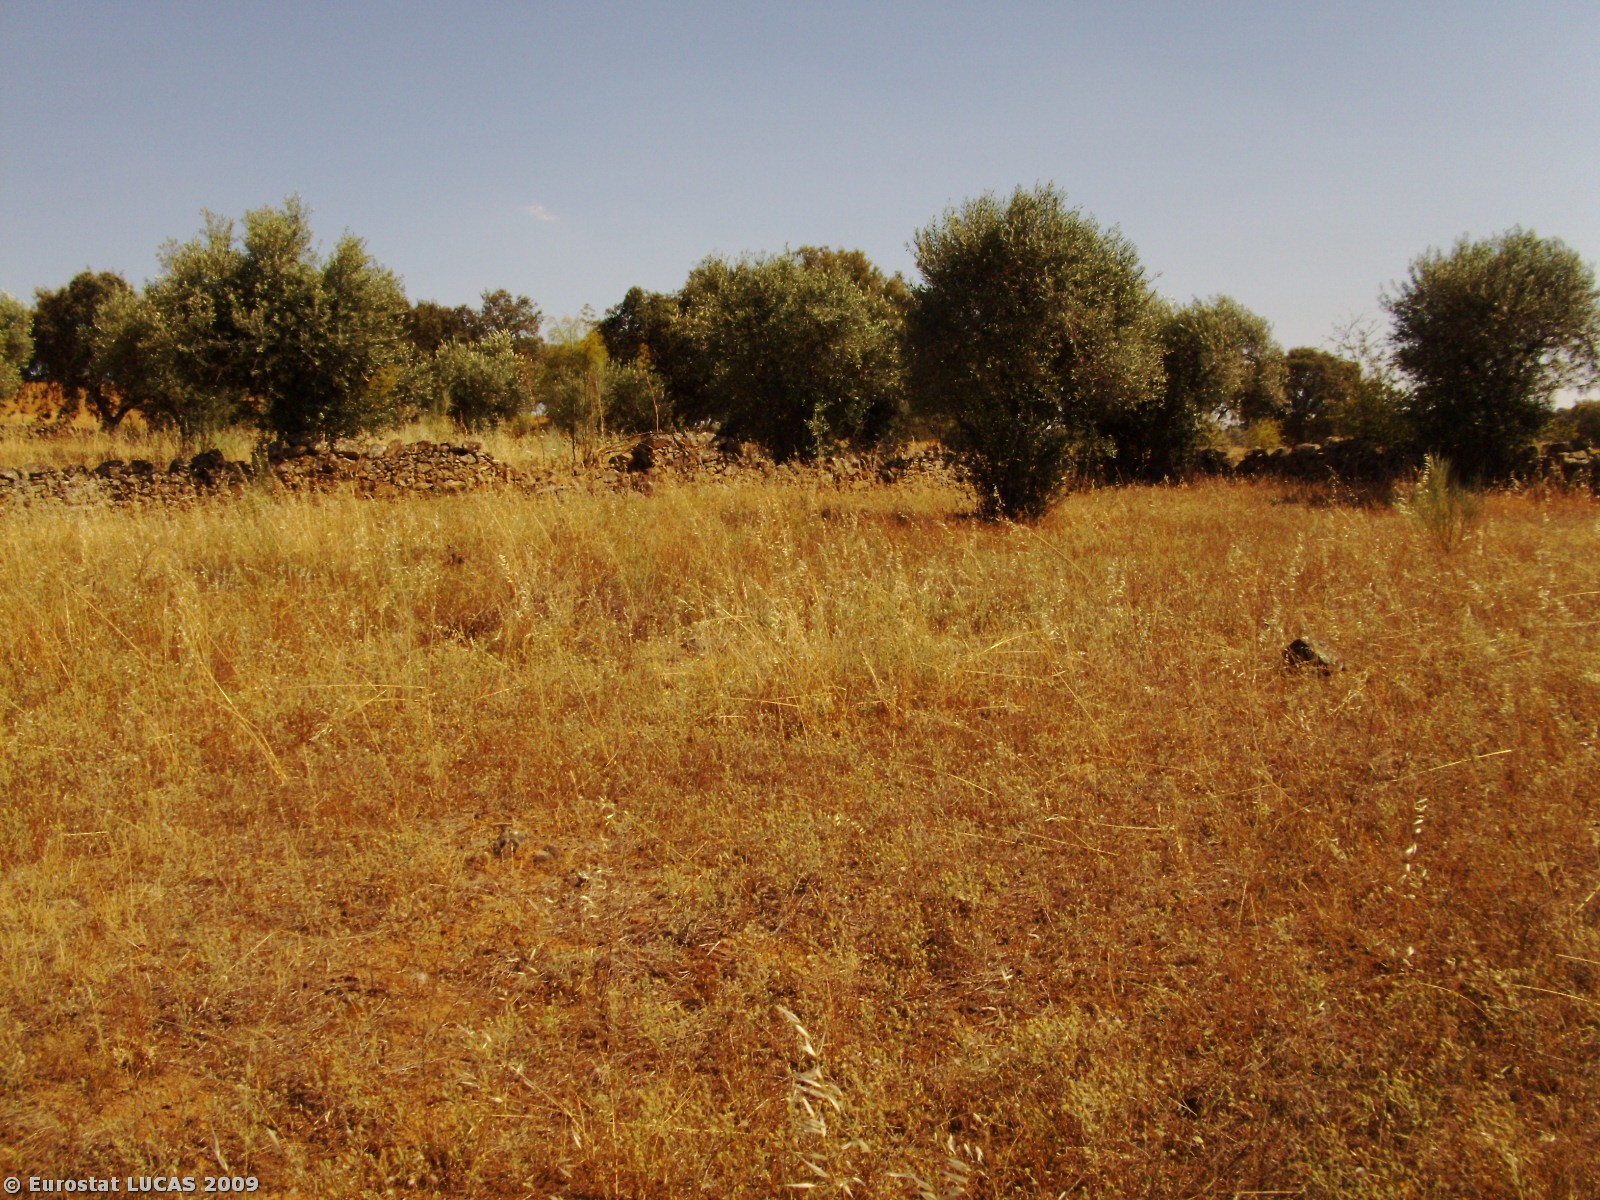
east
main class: Cropland
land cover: Olive groves
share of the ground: 50 - 75 %
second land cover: Spontaneously vegetated surfaces
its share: 25 - 50 %
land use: Agriculture (excluding fallow land and kitchen gardens)
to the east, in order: Olive groves; Spontaneously vegetated surfaces; Olive groves; Dry stone walls; Fences; Spontaneously vegetated surfaces; Fences; Olive groves; Dry stone walls; Bare land; Tracks; Bare land
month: June
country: PT
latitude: 39.8603
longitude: -7.0985
